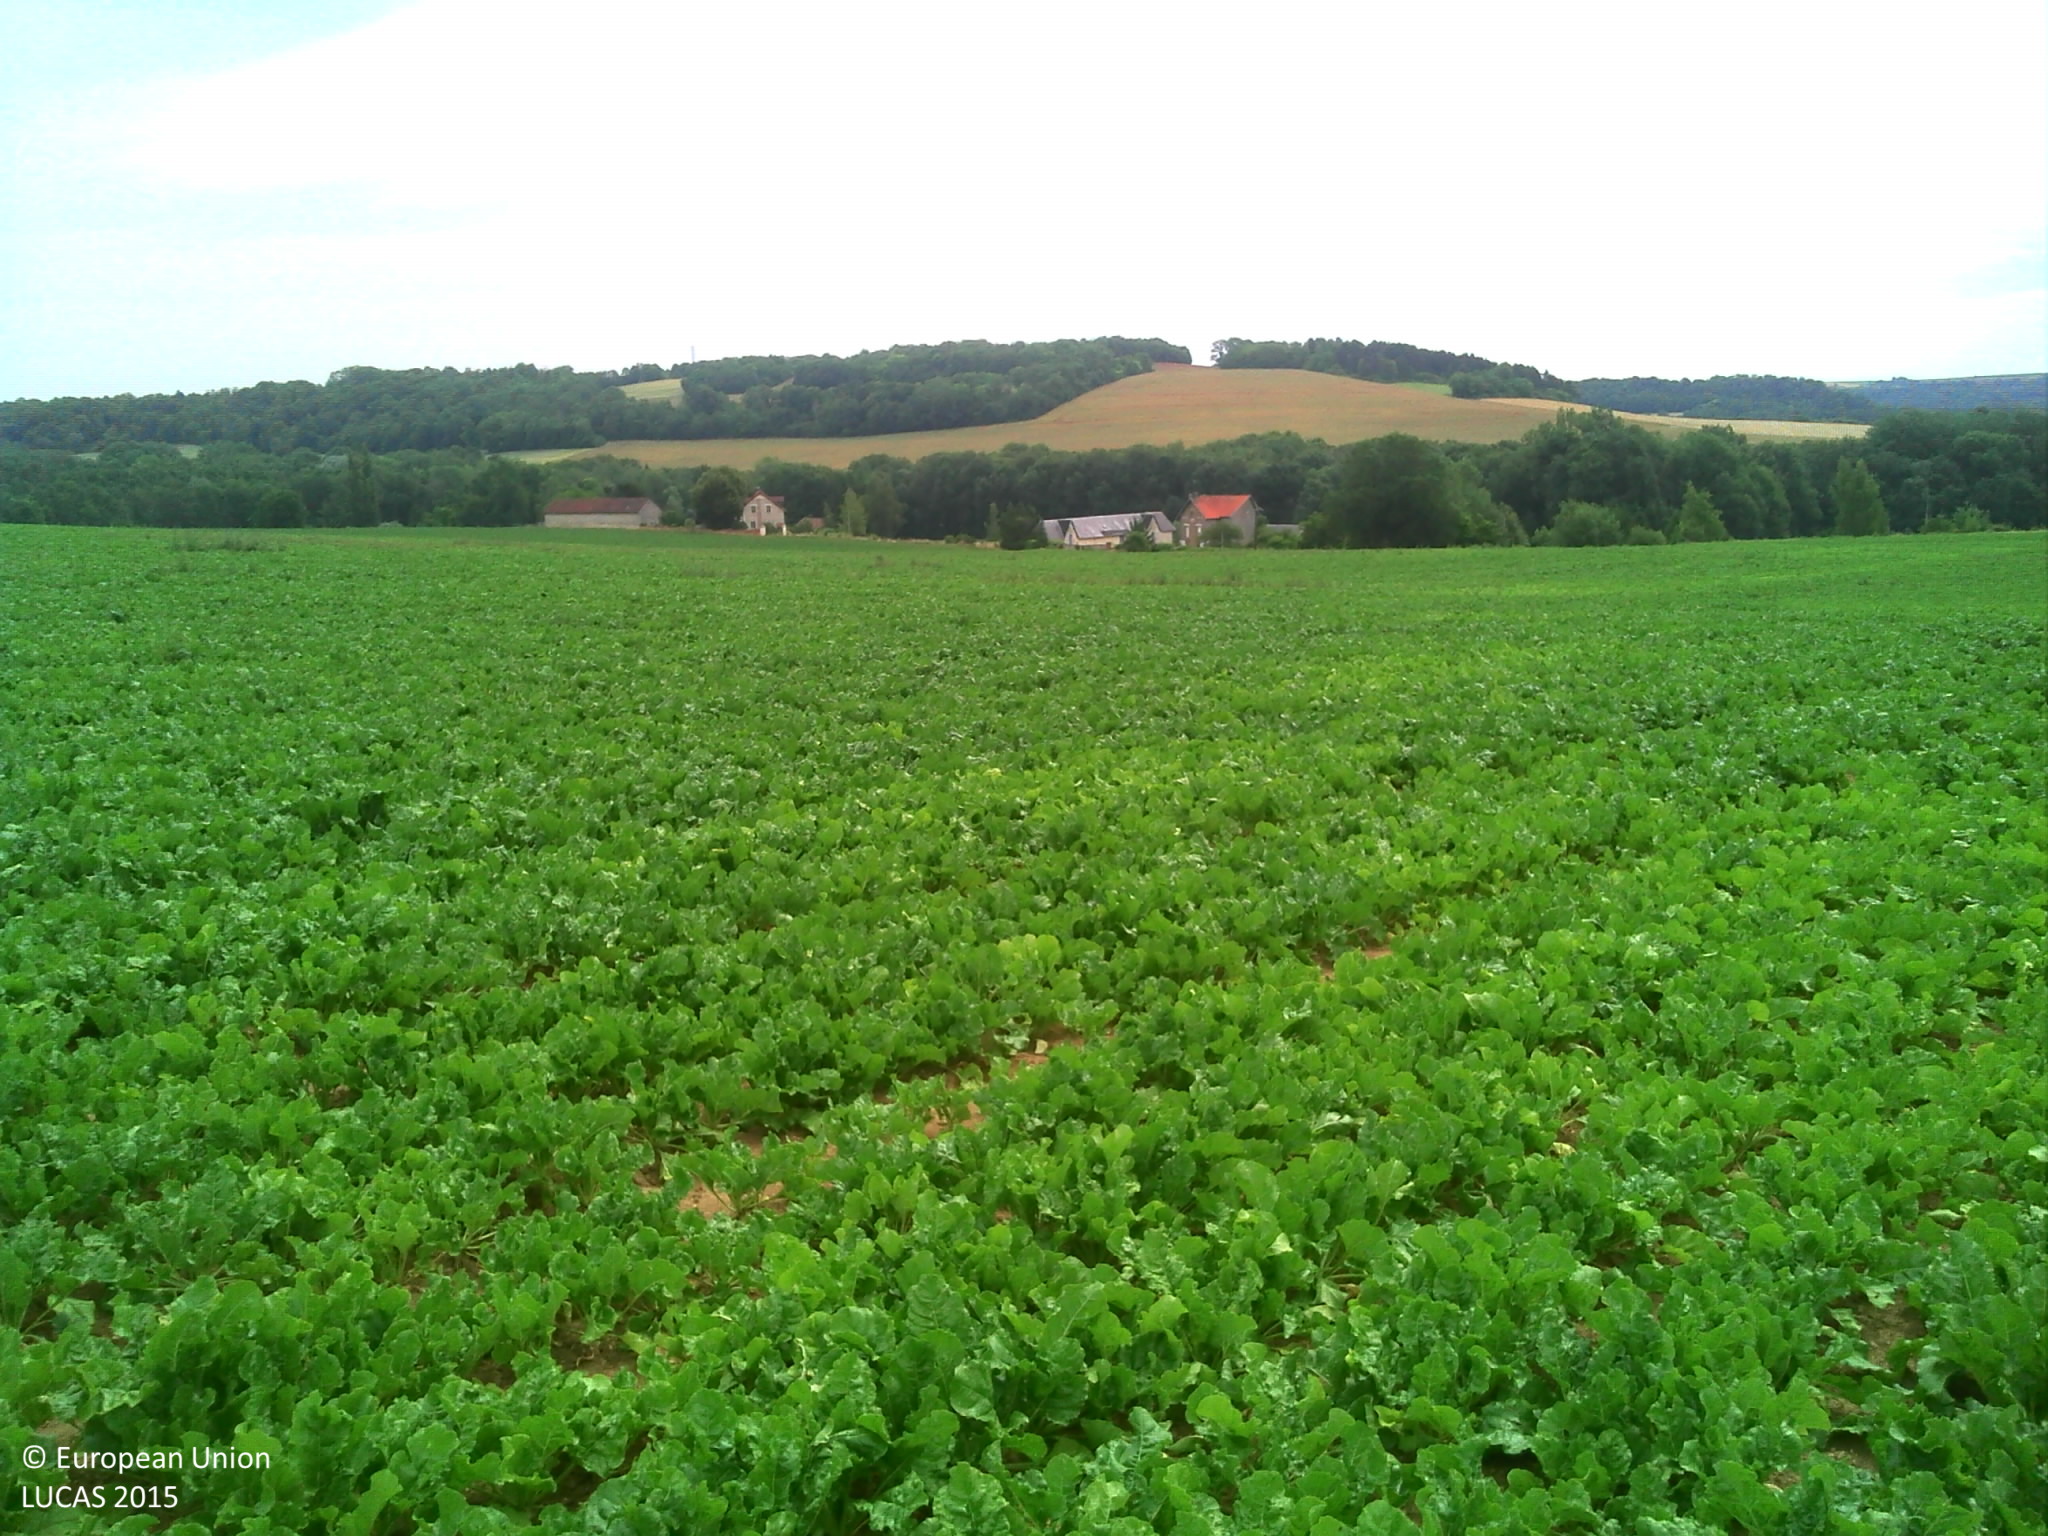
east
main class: Cropland
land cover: Sugar beet
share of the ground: > 75 %
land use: Agriculture (excluding fallow land and kitchen gardens)
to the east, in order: Sugar beet
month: June
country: FR
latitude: 49.4292
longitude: 3.6371
